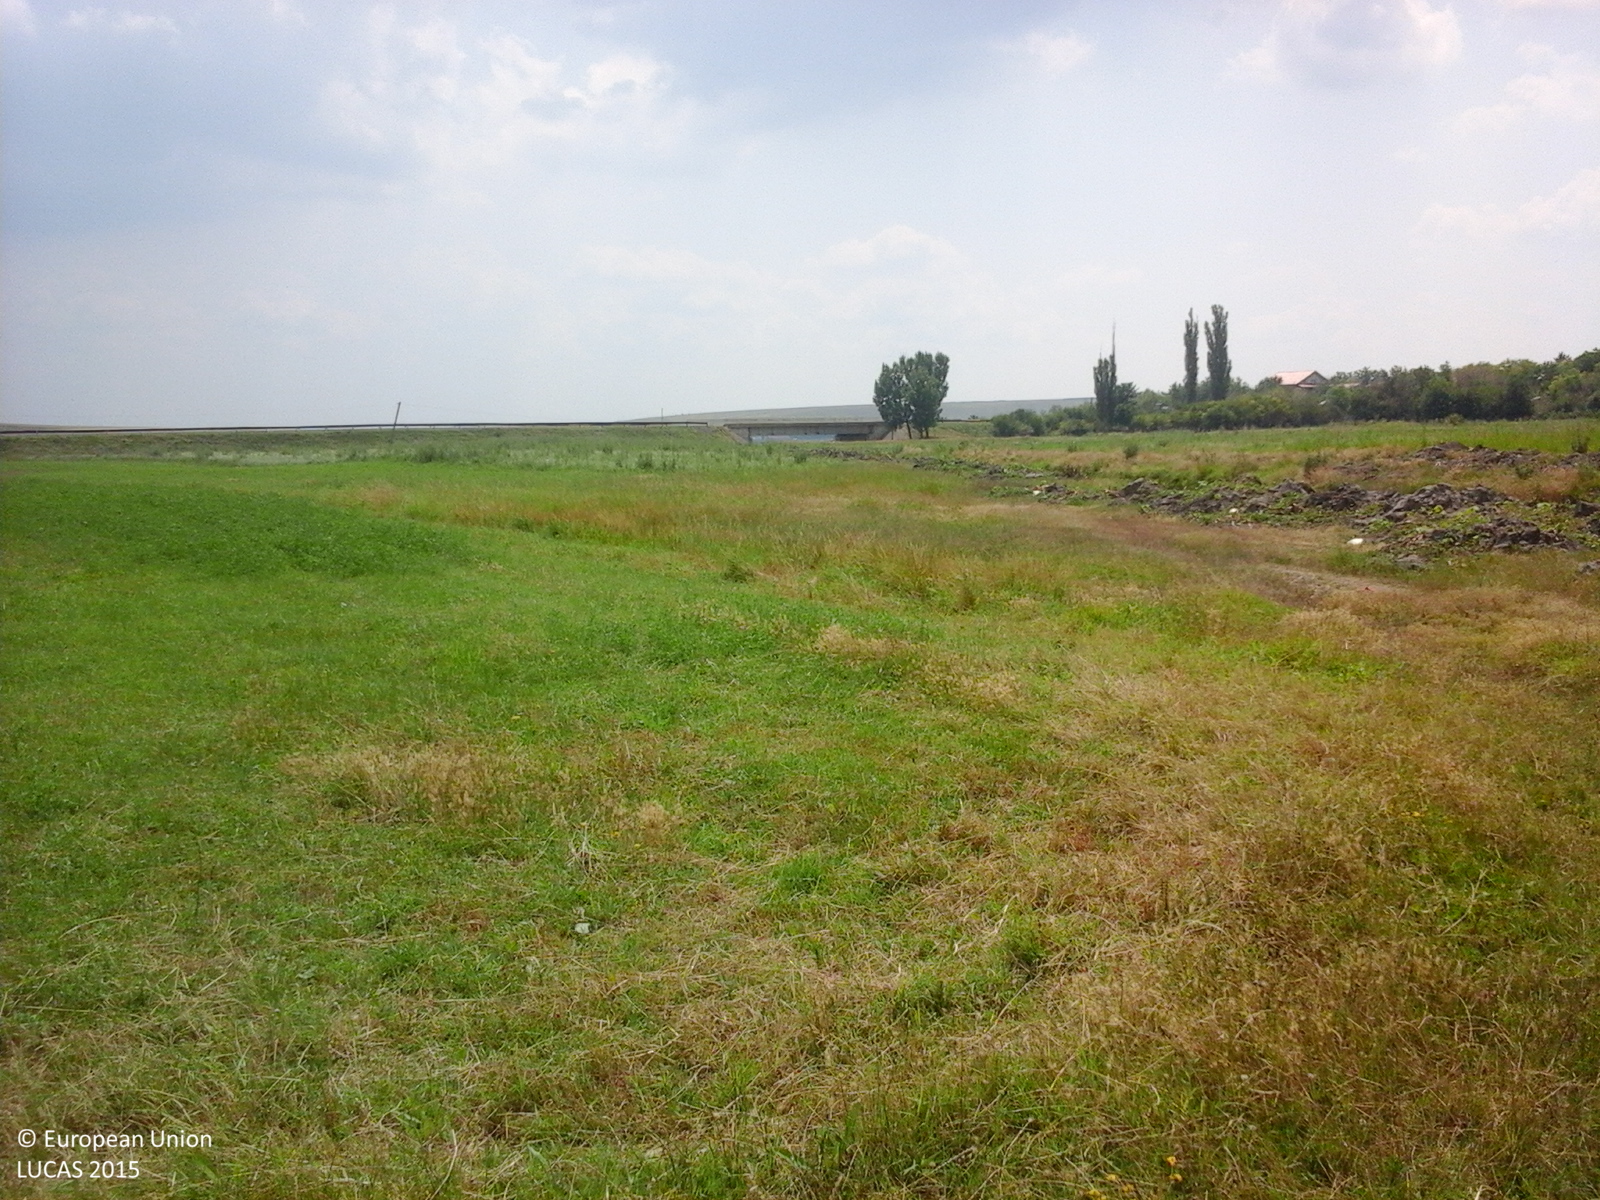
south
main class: Grassland
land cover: Grassland without tree/shrub cover
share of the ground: > 75 %
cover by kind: herbaceous plants 100 %
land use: Agriculture (excluding fallow land and kitchen gardens)
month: July
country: RO
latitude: 43.7981
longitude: 25.1535
